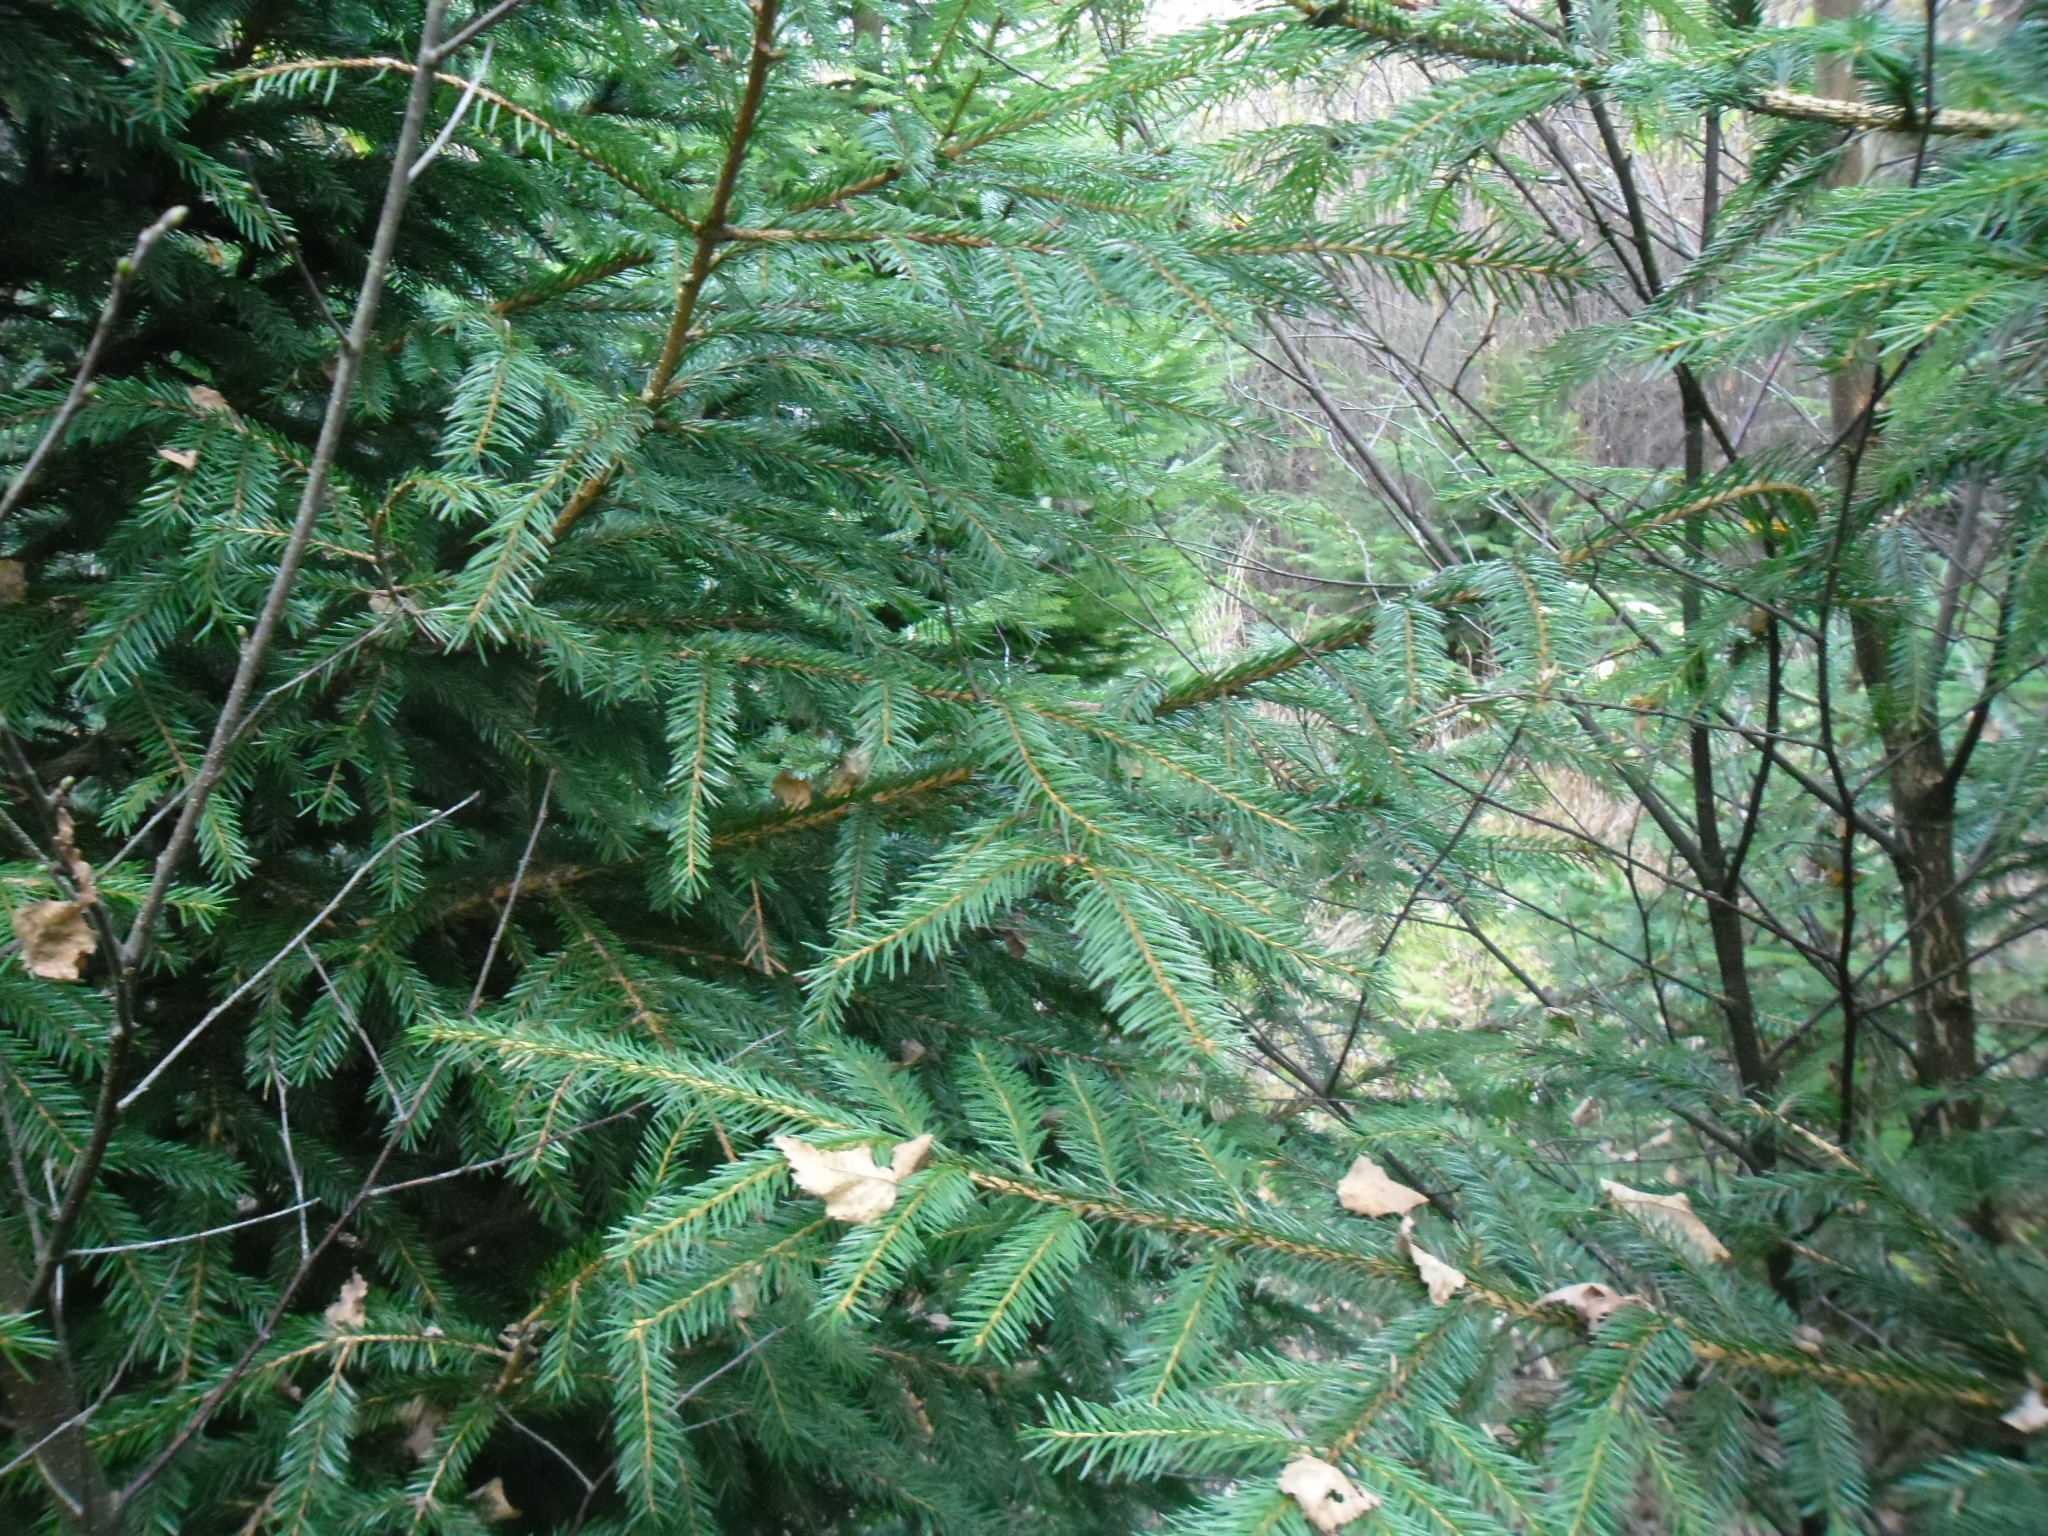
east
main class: Woodland
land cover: Spruce dominated mixed woodland
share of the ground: > 75 %
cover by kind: coniferous forest trees 65 %, broadleaved forest trees 35 %
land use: Forestry
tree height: < 5 m
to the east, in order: Spruce dominated mixed woodland; Broadleaved woodland; Rivers and streams; Broadleaved woodland
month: October
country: SE
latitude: 56.6359
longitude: 13.1109
